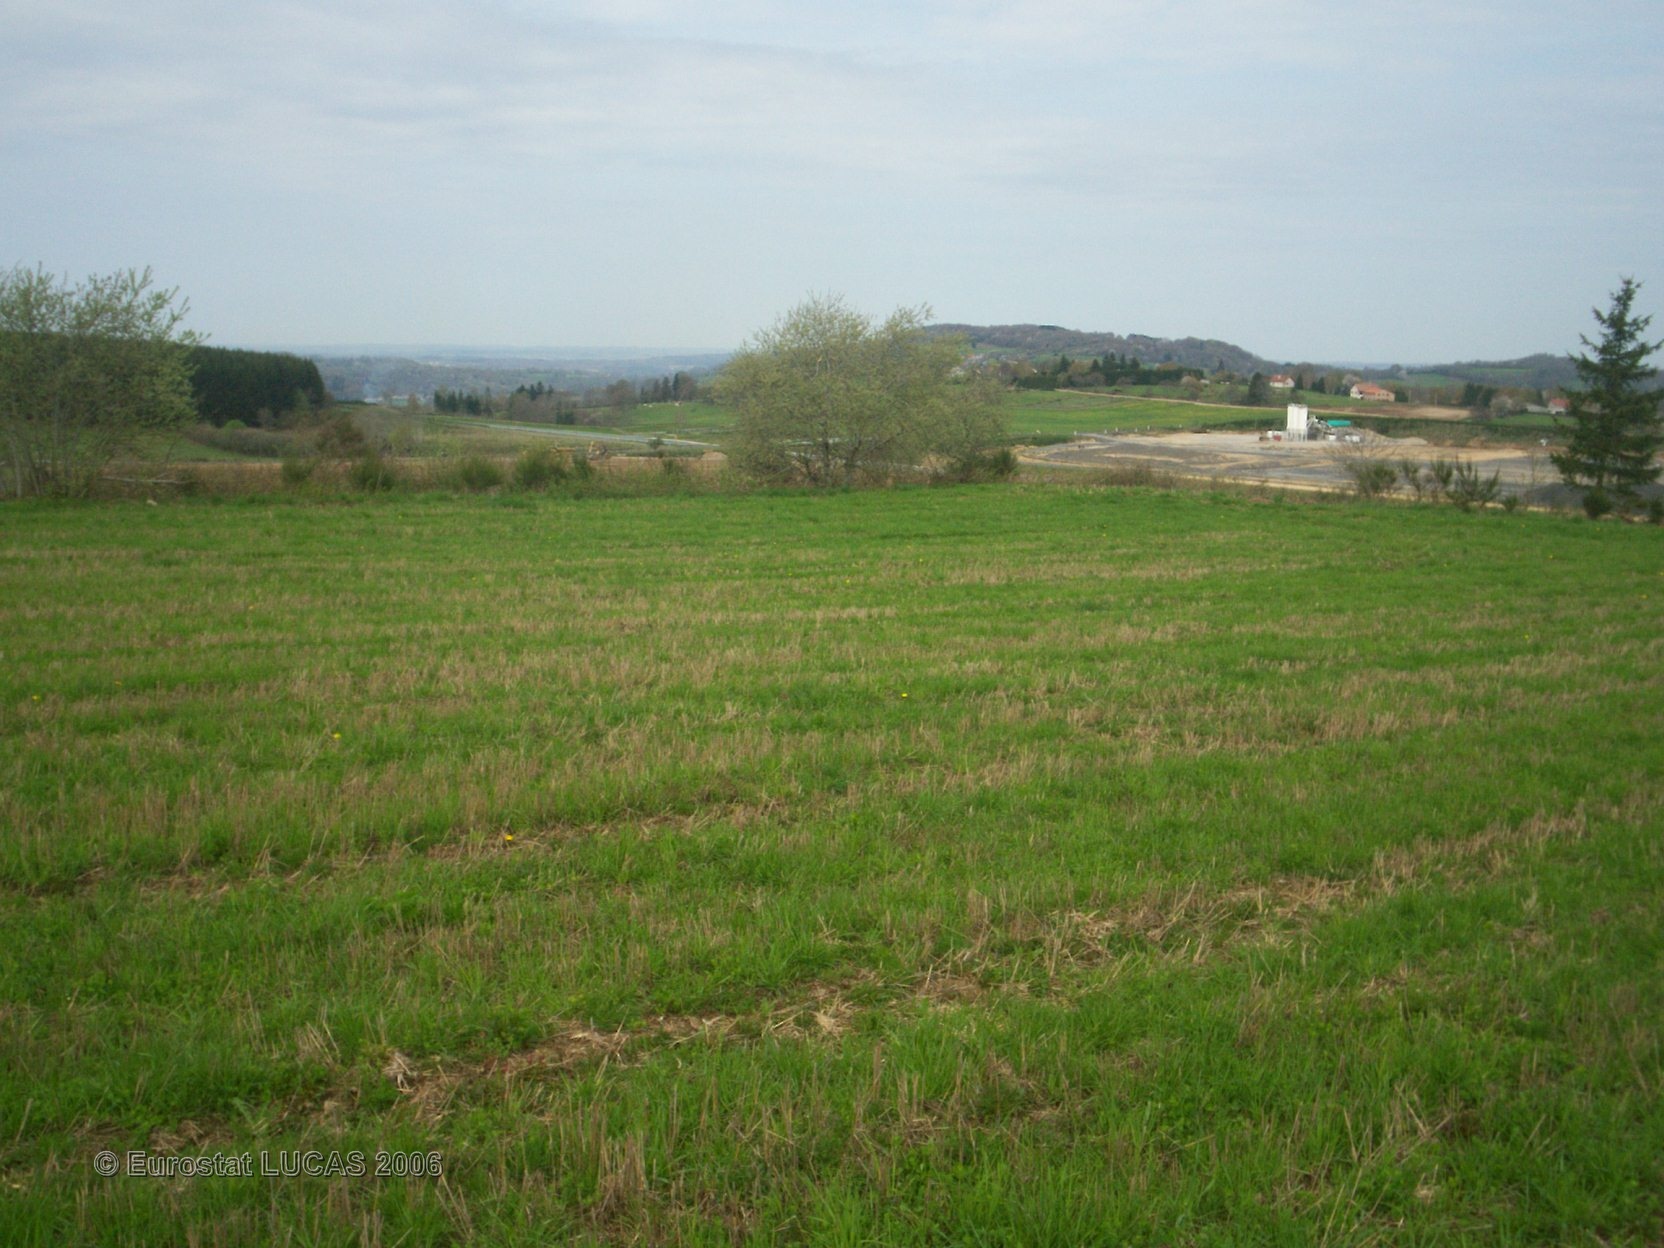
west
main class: Grassland
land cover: Grassland without tree/shrub cover
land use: Agriculture (excluding fallow land and kitchen gardens)
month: May
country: FR
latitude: 45.8818
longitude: 2.9249
